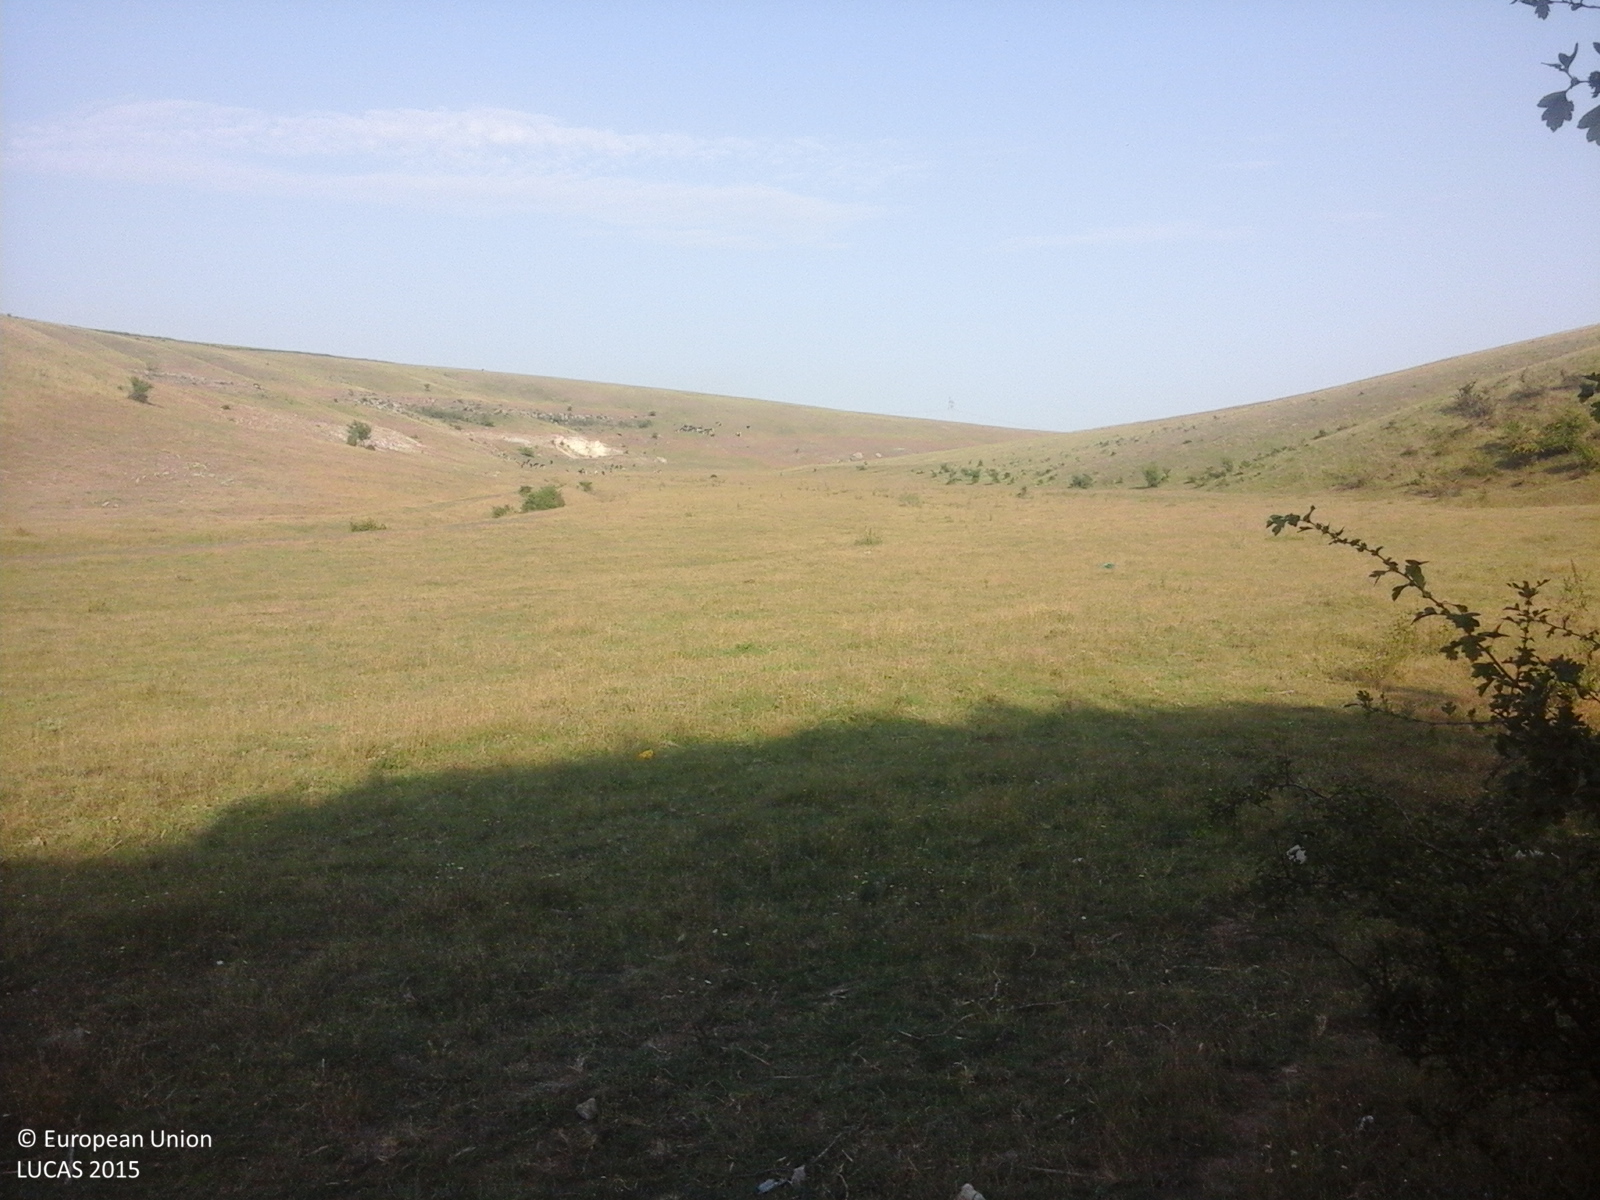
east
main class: Grassland
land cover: Grassland with sparse tree/shrub cover
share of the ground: > 75 %
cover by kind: herbaceous plants 95 %, broadleaved forest trees 5 %
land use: Semi-natural and natural areas not in use
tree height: < 5 m
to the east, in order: Grassland with sparse tree/shrub cover; Grassland without tree/shrub cover; Ditches and canals; Grassland without tree/shrub cover
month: August
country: RO
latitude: 44.1191
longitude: 28.0361
